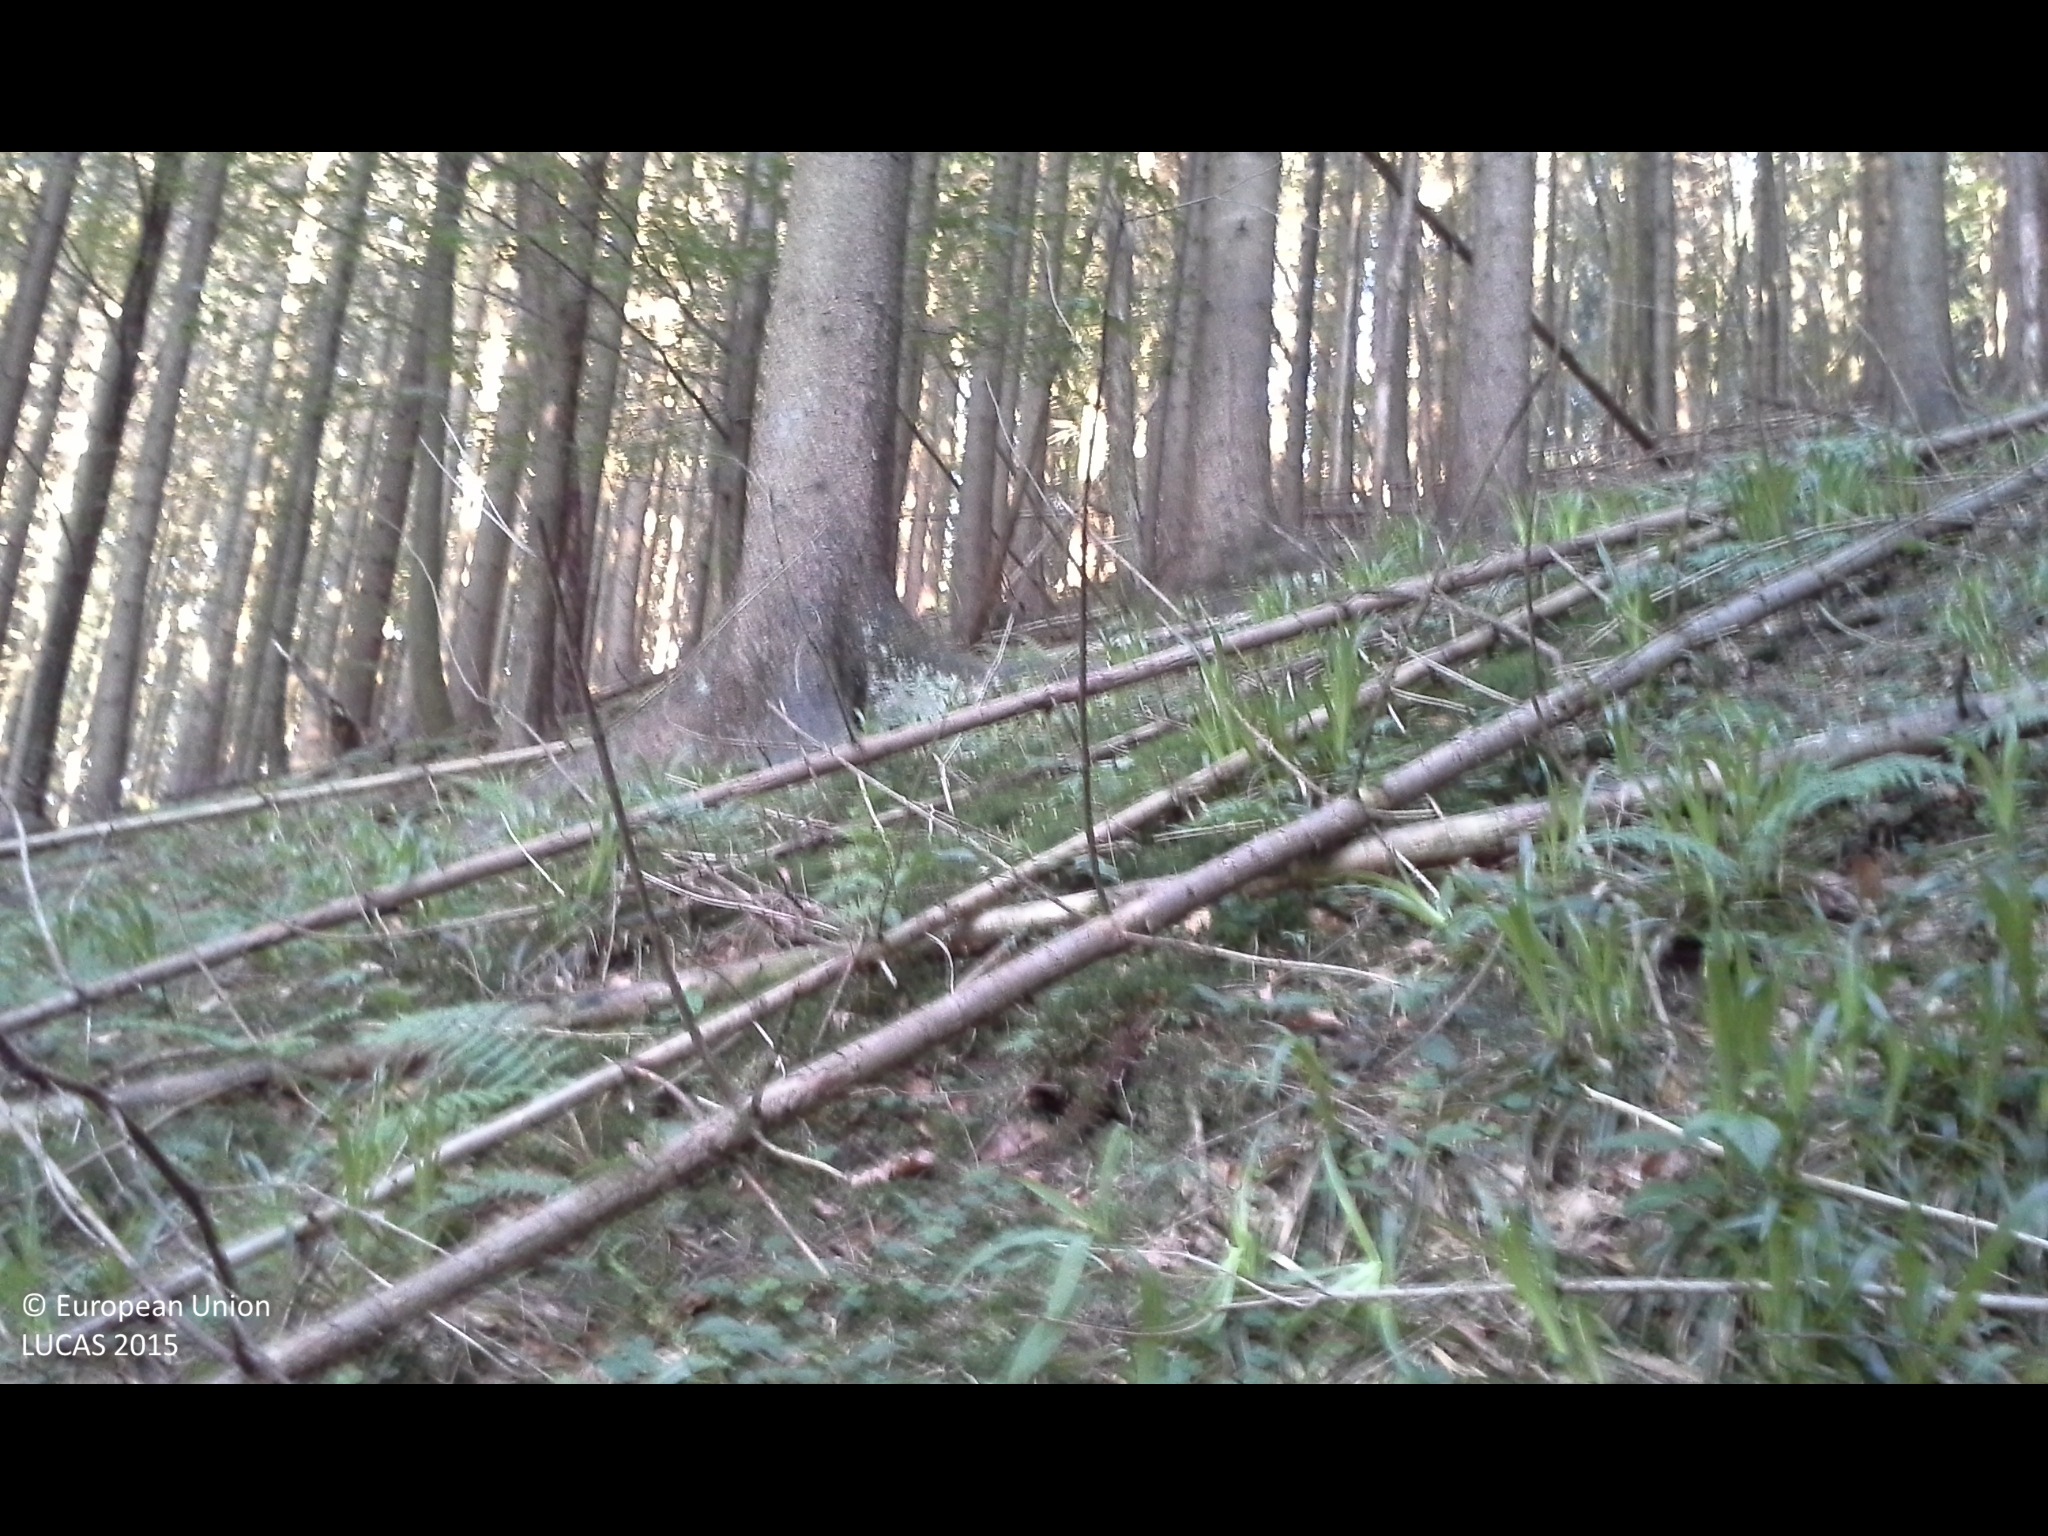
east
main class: Woodland
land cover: Spruce dominated mixed woodland
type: hemiboreal forest and nemoral coniferous forest and mixed broadleaved-coniferous forest
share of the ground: > 75 %
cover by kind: coniferous forest trees 75 %, broadleaved forest trees 25 %
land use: Forestry
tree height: > 5 m
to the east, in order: Spruce dominated mixed woodland; Tracks; Spruce dominated mixed woodland; Rivers and streams; Spruce dominated mixed woodland; Spruce dominated coniferous woodland; Rivers and streams; Spruce dominated mixed woodland
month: May
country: AT
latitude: 47.9447
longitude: 14.2169
